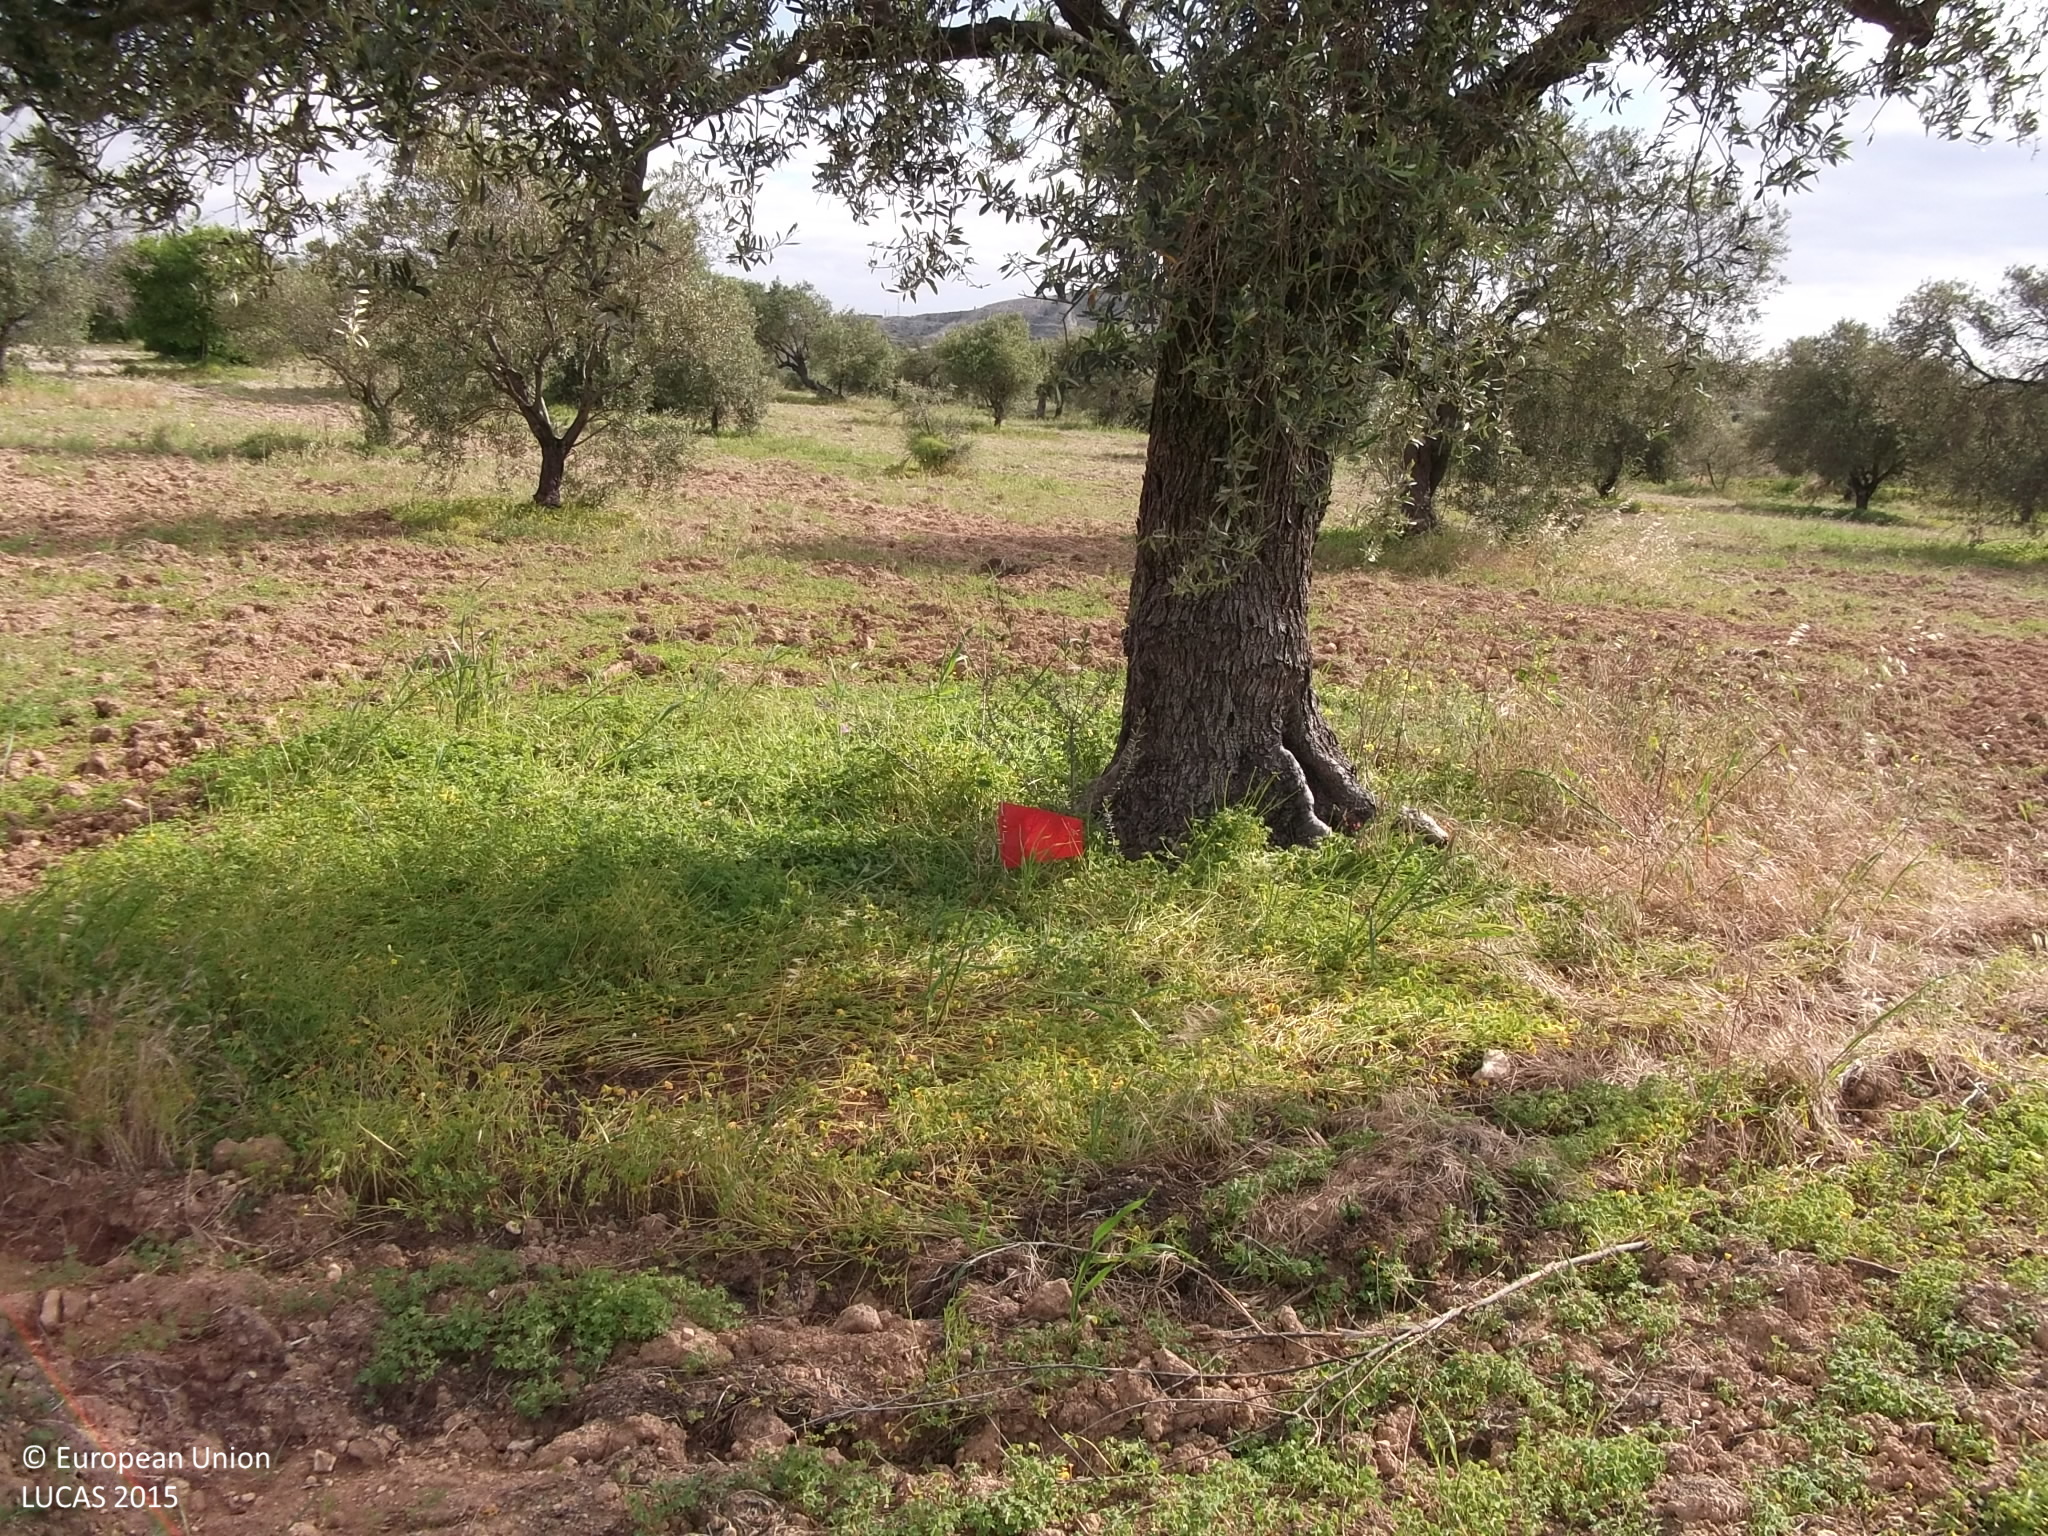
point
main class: Cropland
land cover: Olive groves
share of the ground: 25 - 50 %
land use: Agriculture (excluding fallow land and kitchen gardens)
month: April
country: CY
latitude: 34.8297
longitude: 33.4427
